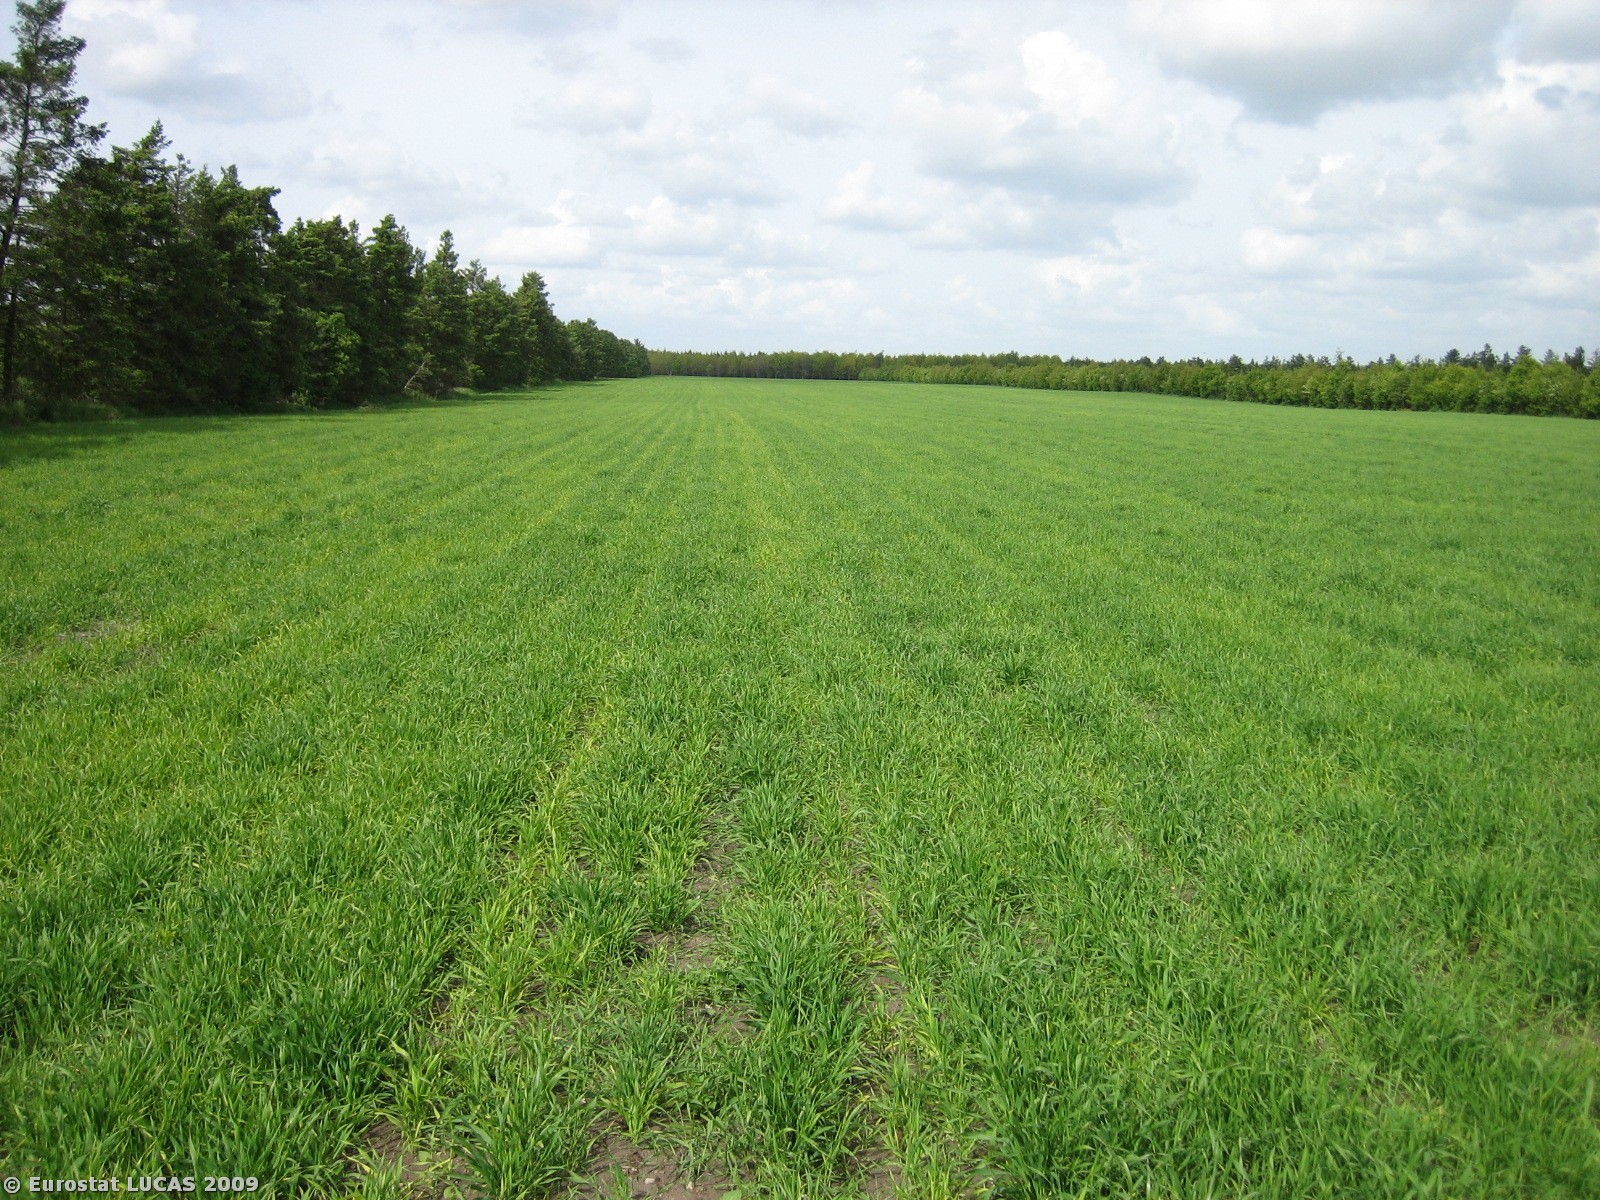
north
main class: Cropland
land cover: Barley
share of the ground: > 75 %
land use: Agriculture (excluding fallow land and kitchen gardens)
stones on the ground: 10 - 25 %
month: May
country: DK
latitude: 56.2192
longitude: 8.9208
